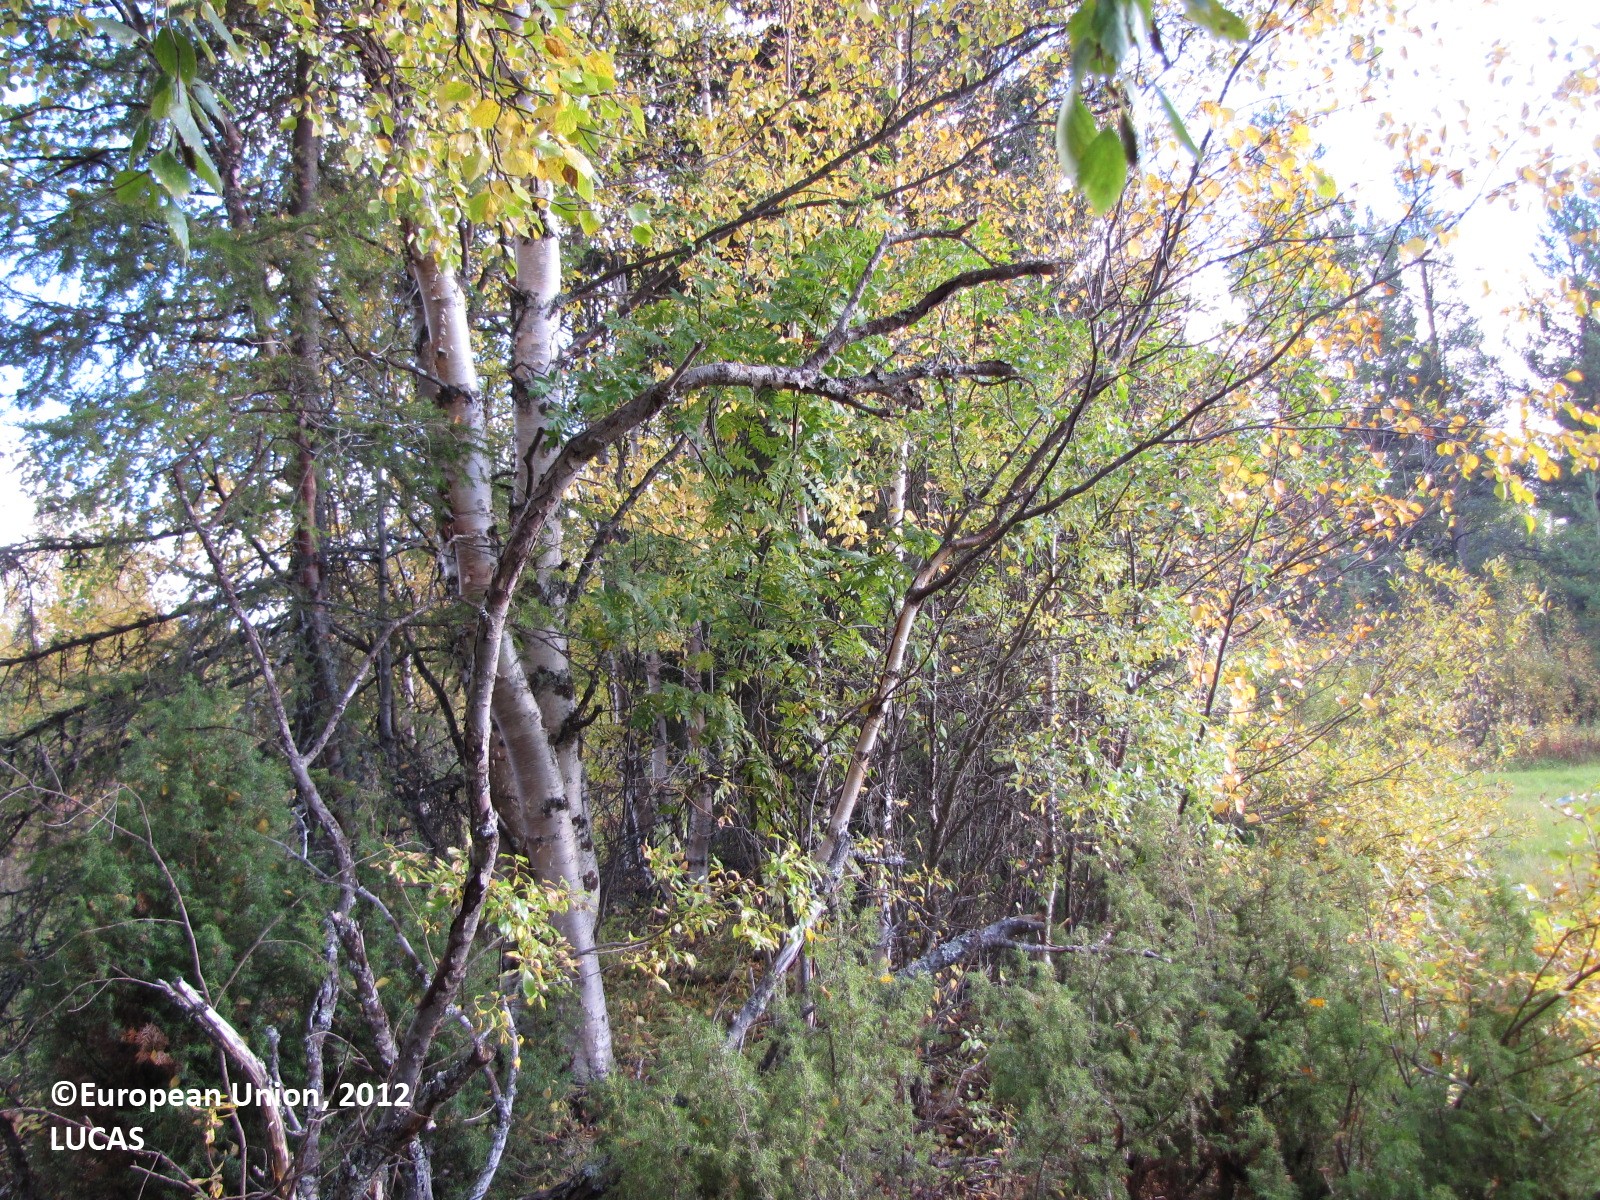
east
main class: Woodland
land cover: Pine dominated mixed woodland
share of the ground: 10 - 25 %
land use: Forestry
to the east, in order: Pine dominated mixed woodland; Tracks; Pine dominated mixed woodland; Ditches and canals; Paved roads, cycling and walking lanes; Ditches and canals; Pine dominated mixed woodland; Pine dominated coniferous woodland; Tracks; Pine dominated coniferous woodland; Inland running water; Shruby margins; Pine dominated mixed woodland; Electric lines; Ditches and canals; Grass margins; Paved roads, cycling and walking lanes; Grass margins
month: September
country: FI
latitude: 67.3706
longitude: 24.8745
